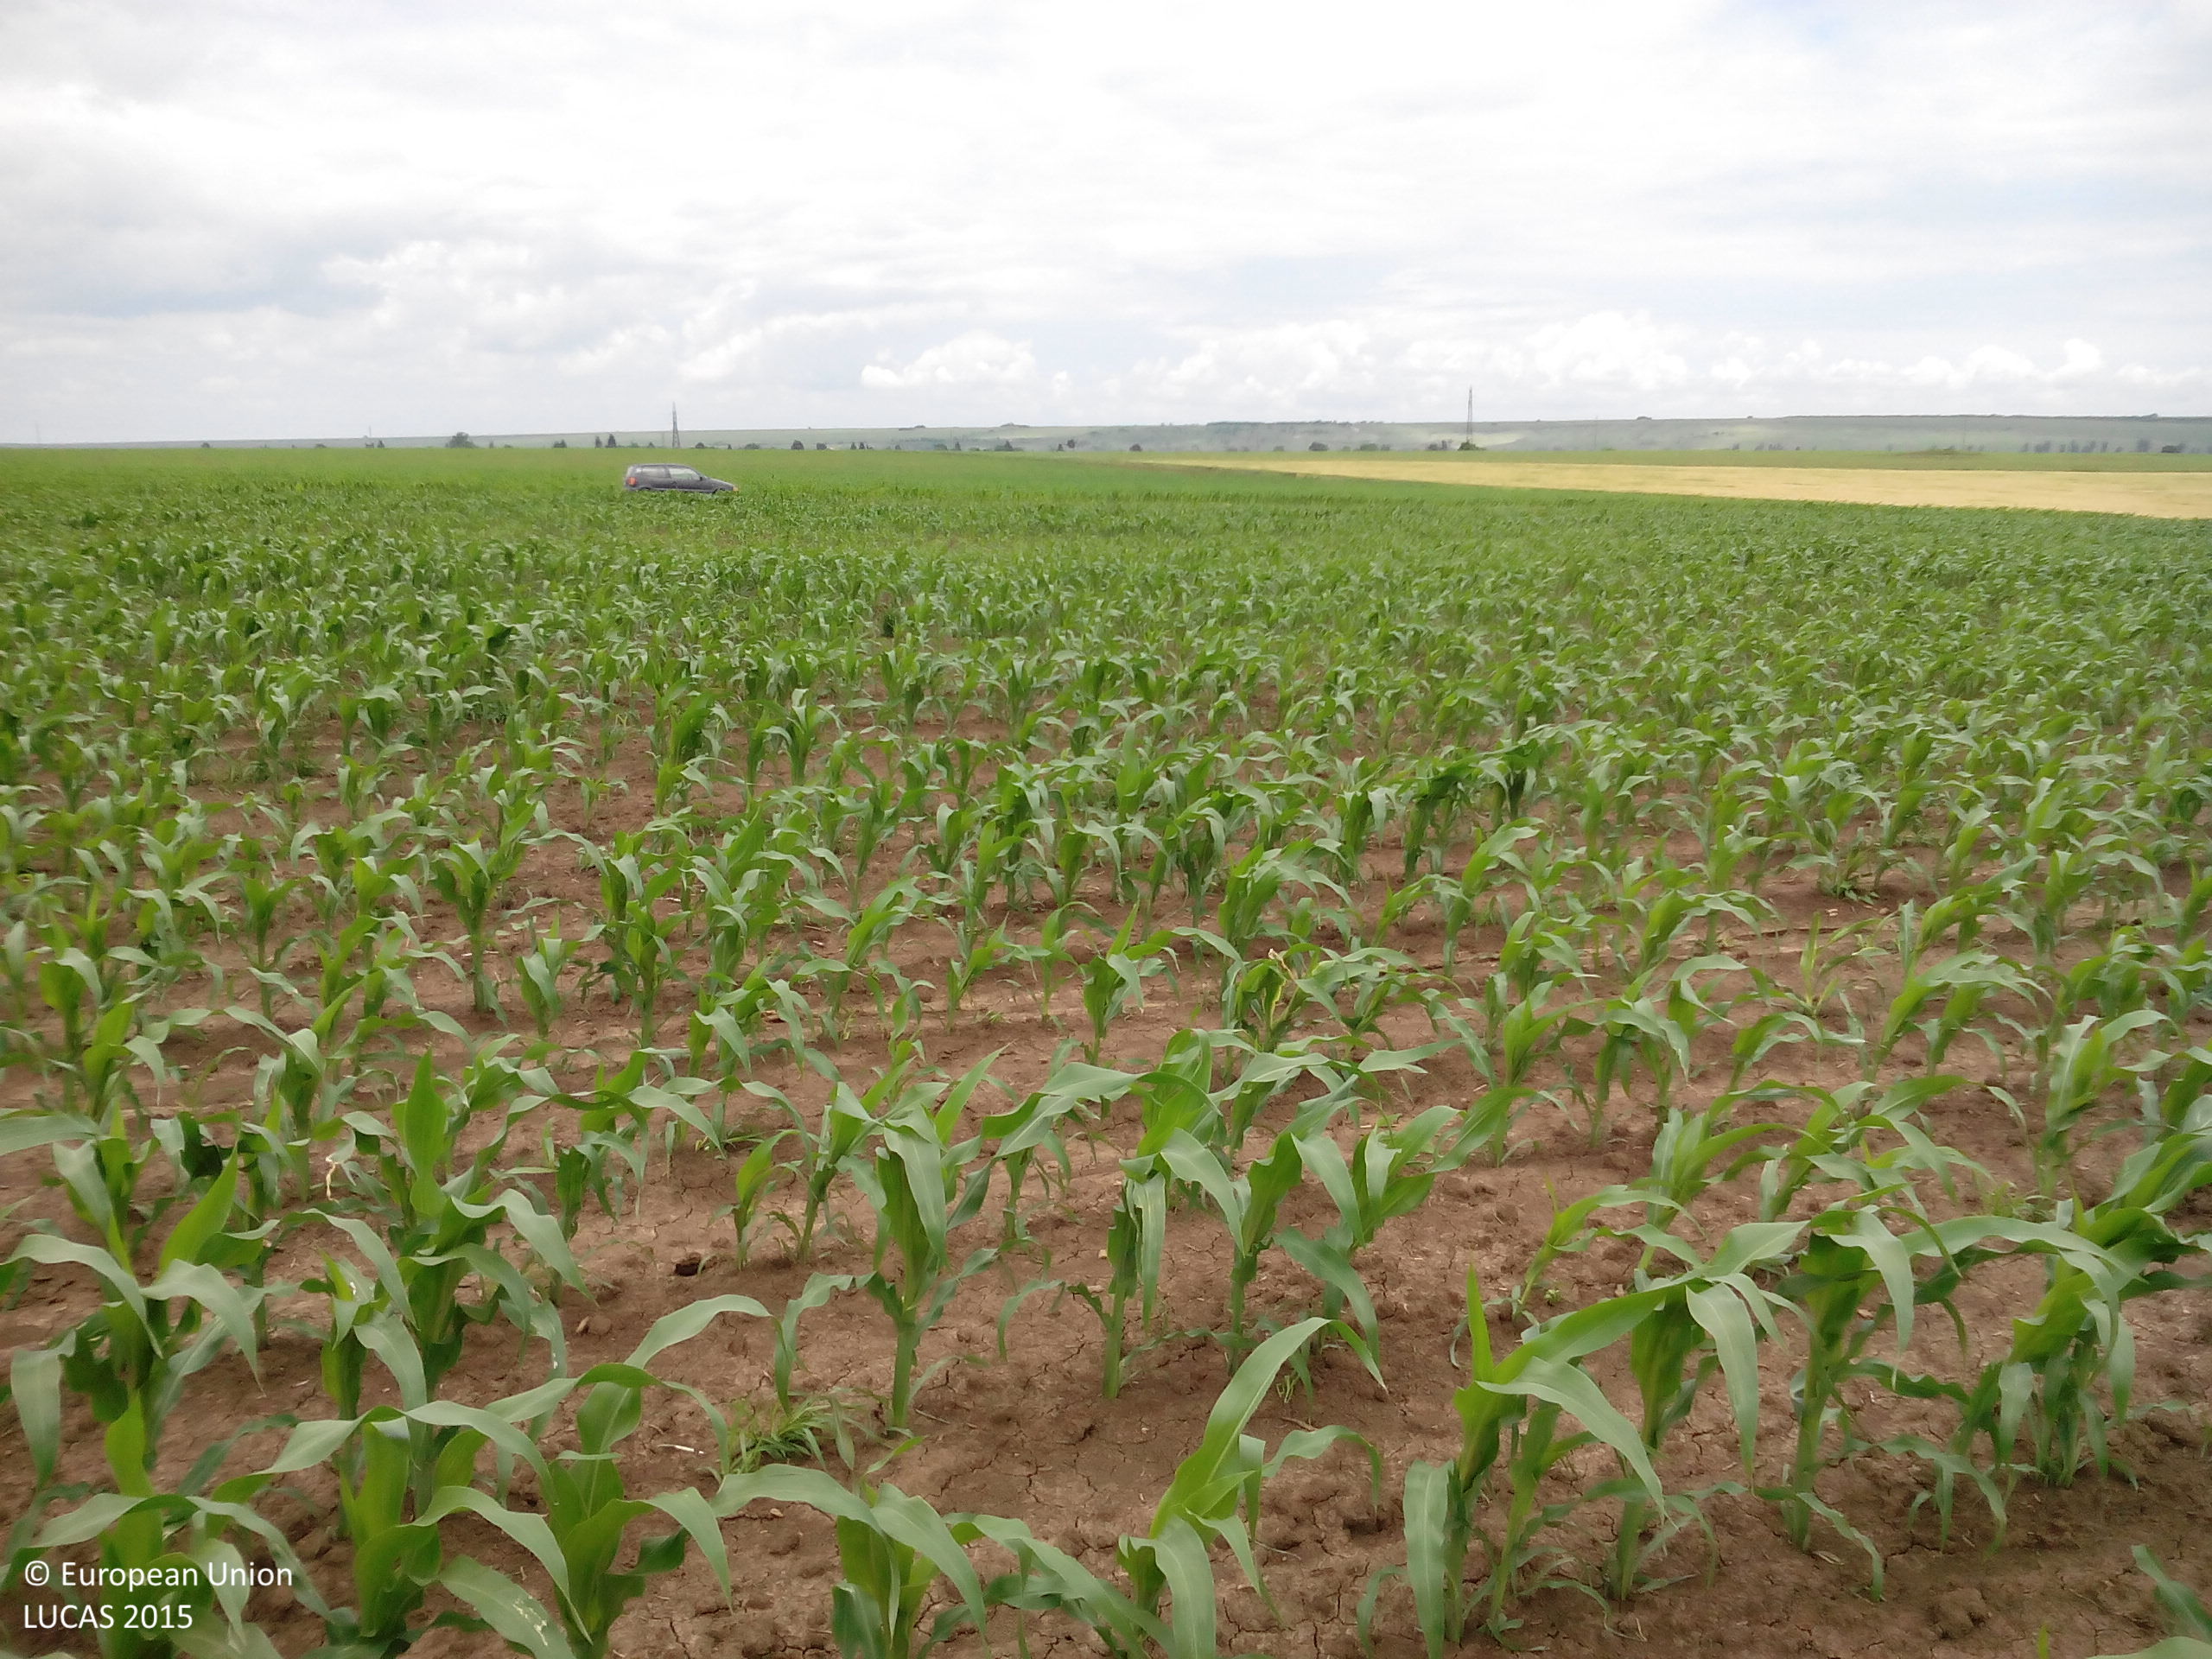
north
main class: Cropland
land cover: Maize
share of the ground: 50 - 75 %
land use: Agriculture (excluding fallow land and kitchen gardens)
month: May
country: BG
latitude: 43.4848
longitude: 23.8864
